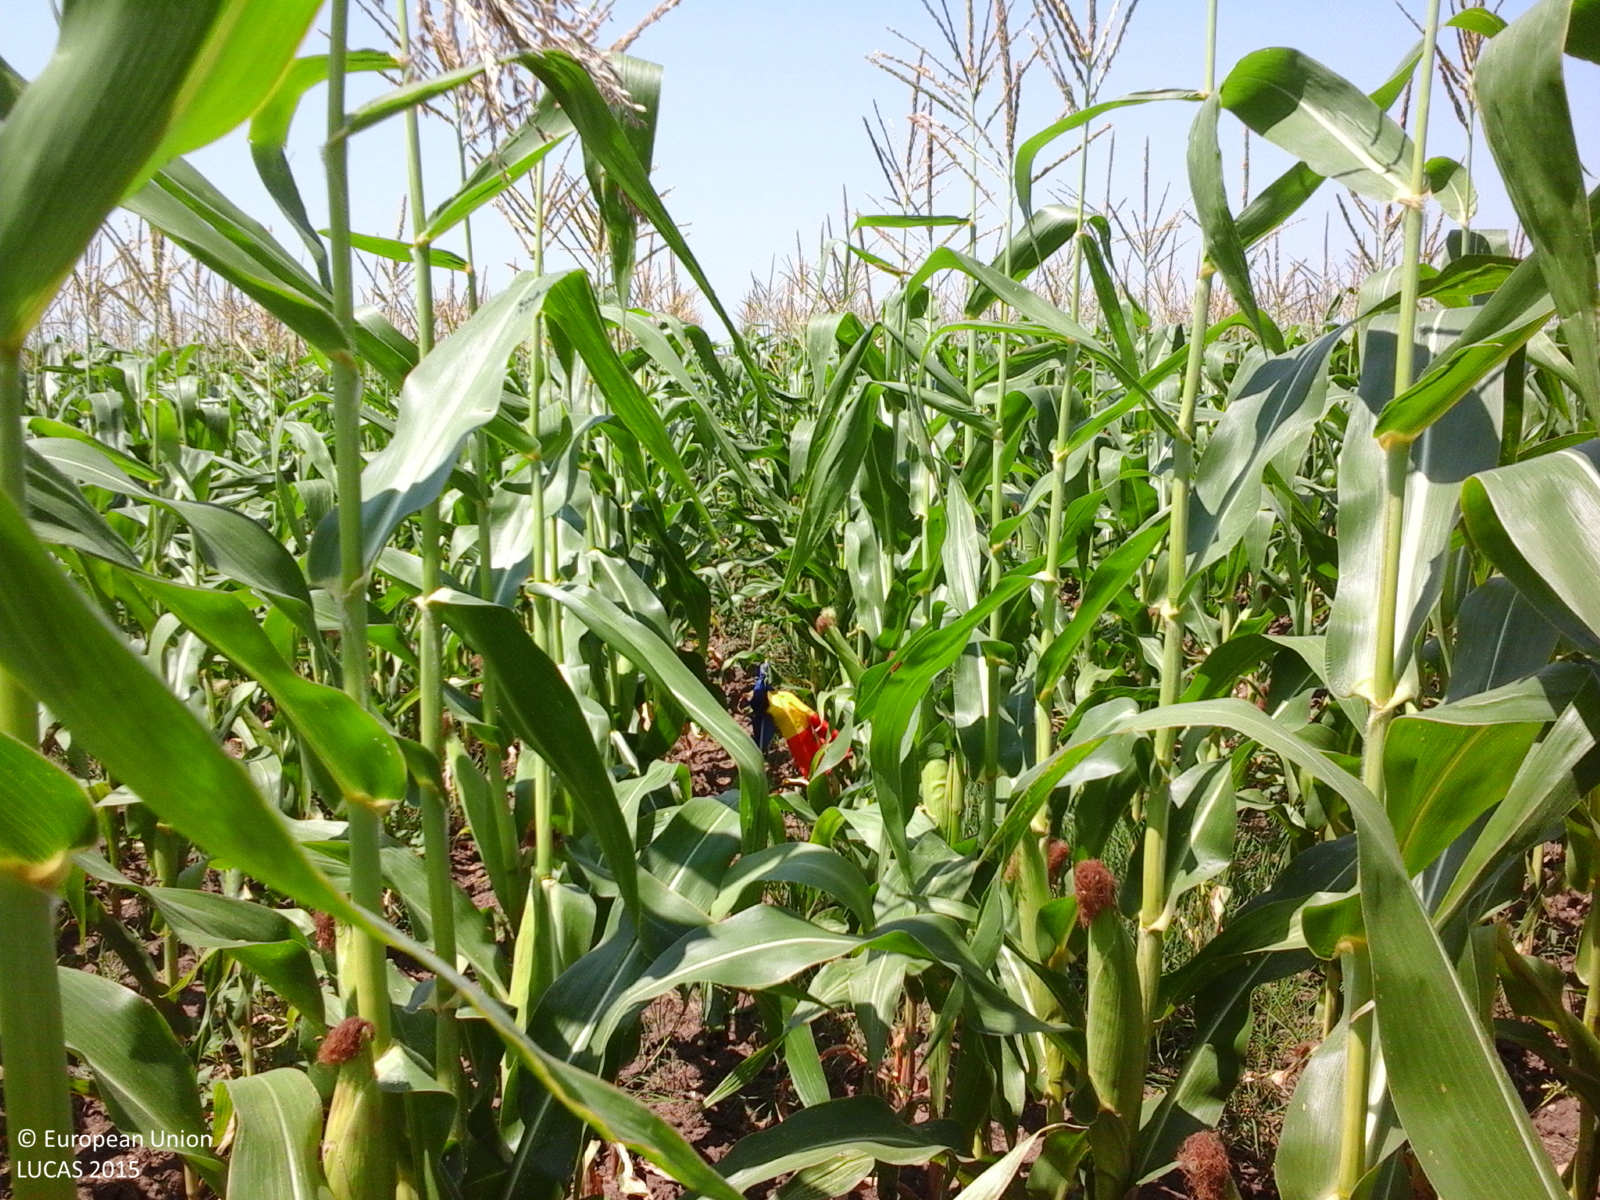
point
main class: Cropland
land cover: Maize
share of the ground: > 75 %
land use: Agriculture (excluding fallow land and kitchen gardens)
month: July
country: RO
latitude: 44.9261
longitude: 27.3094
